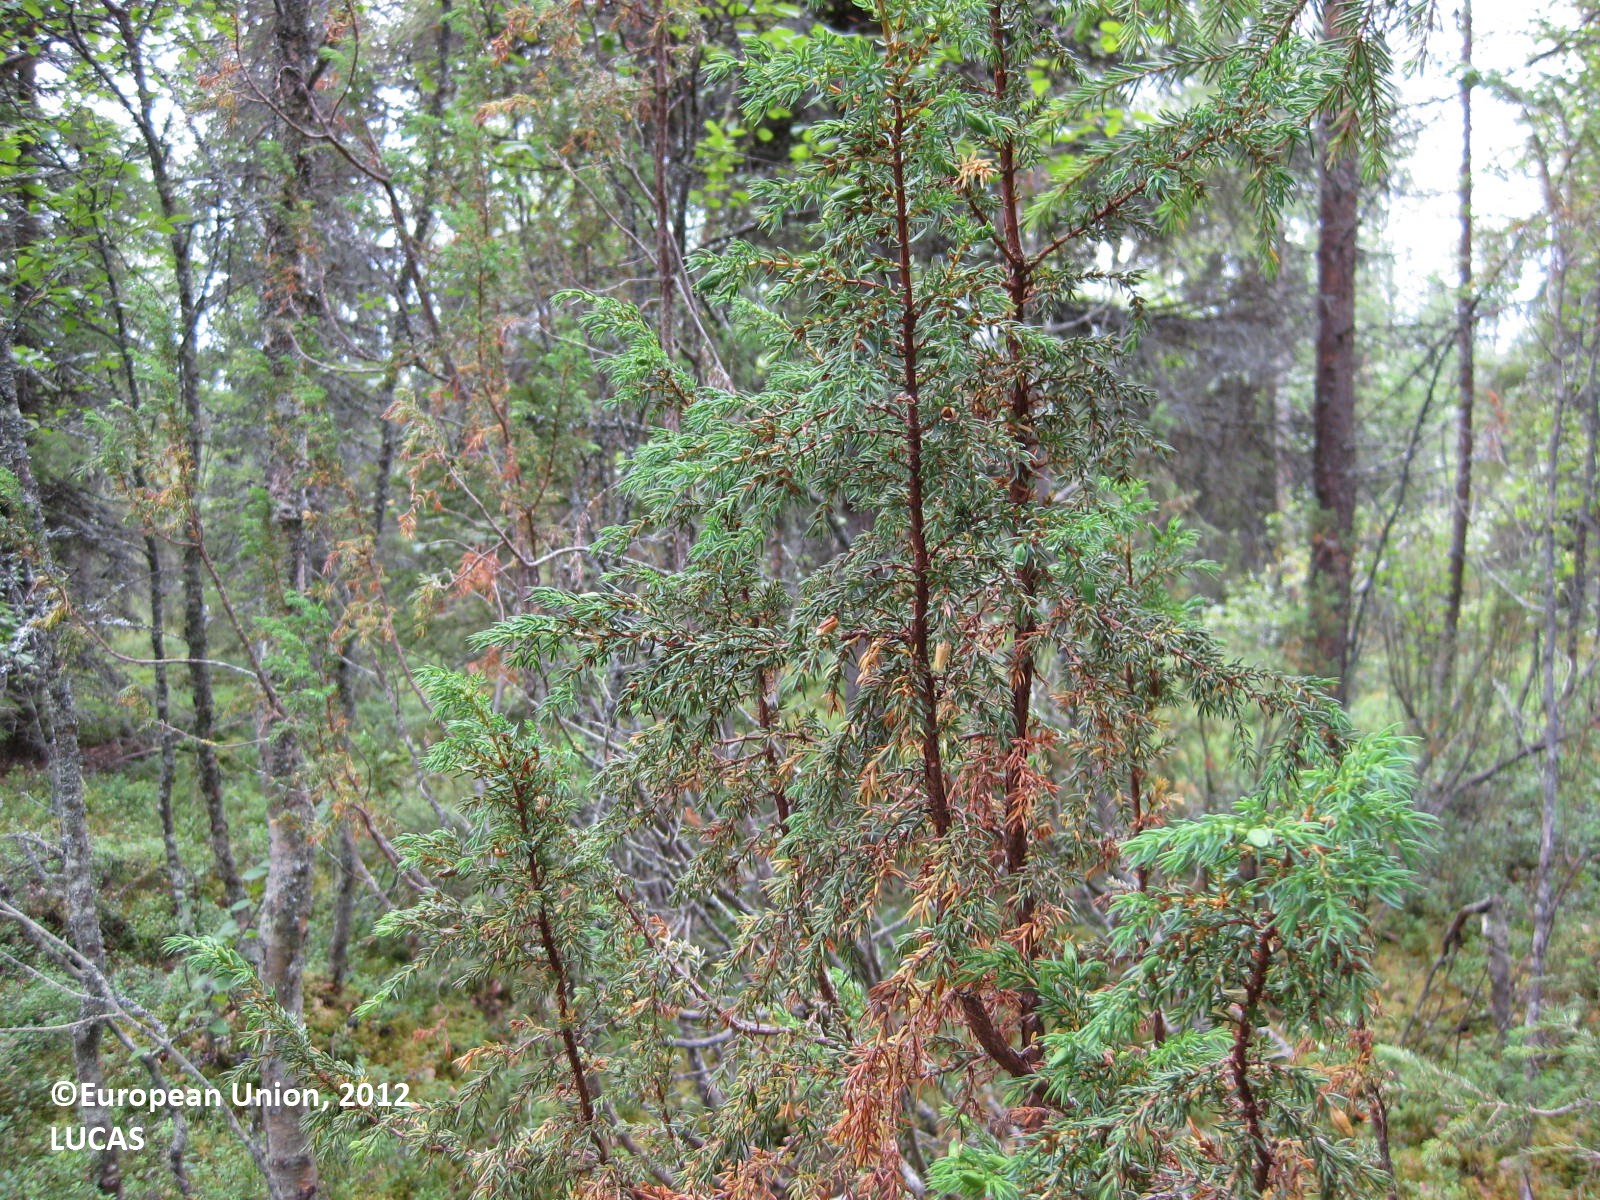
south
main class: Woodland
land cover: Other mixed woodland
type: boreal forest
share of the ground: > 75 %
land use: Forestry
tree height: > 5 m
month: August
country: FI
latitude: 66.3839
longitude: 28.4676
